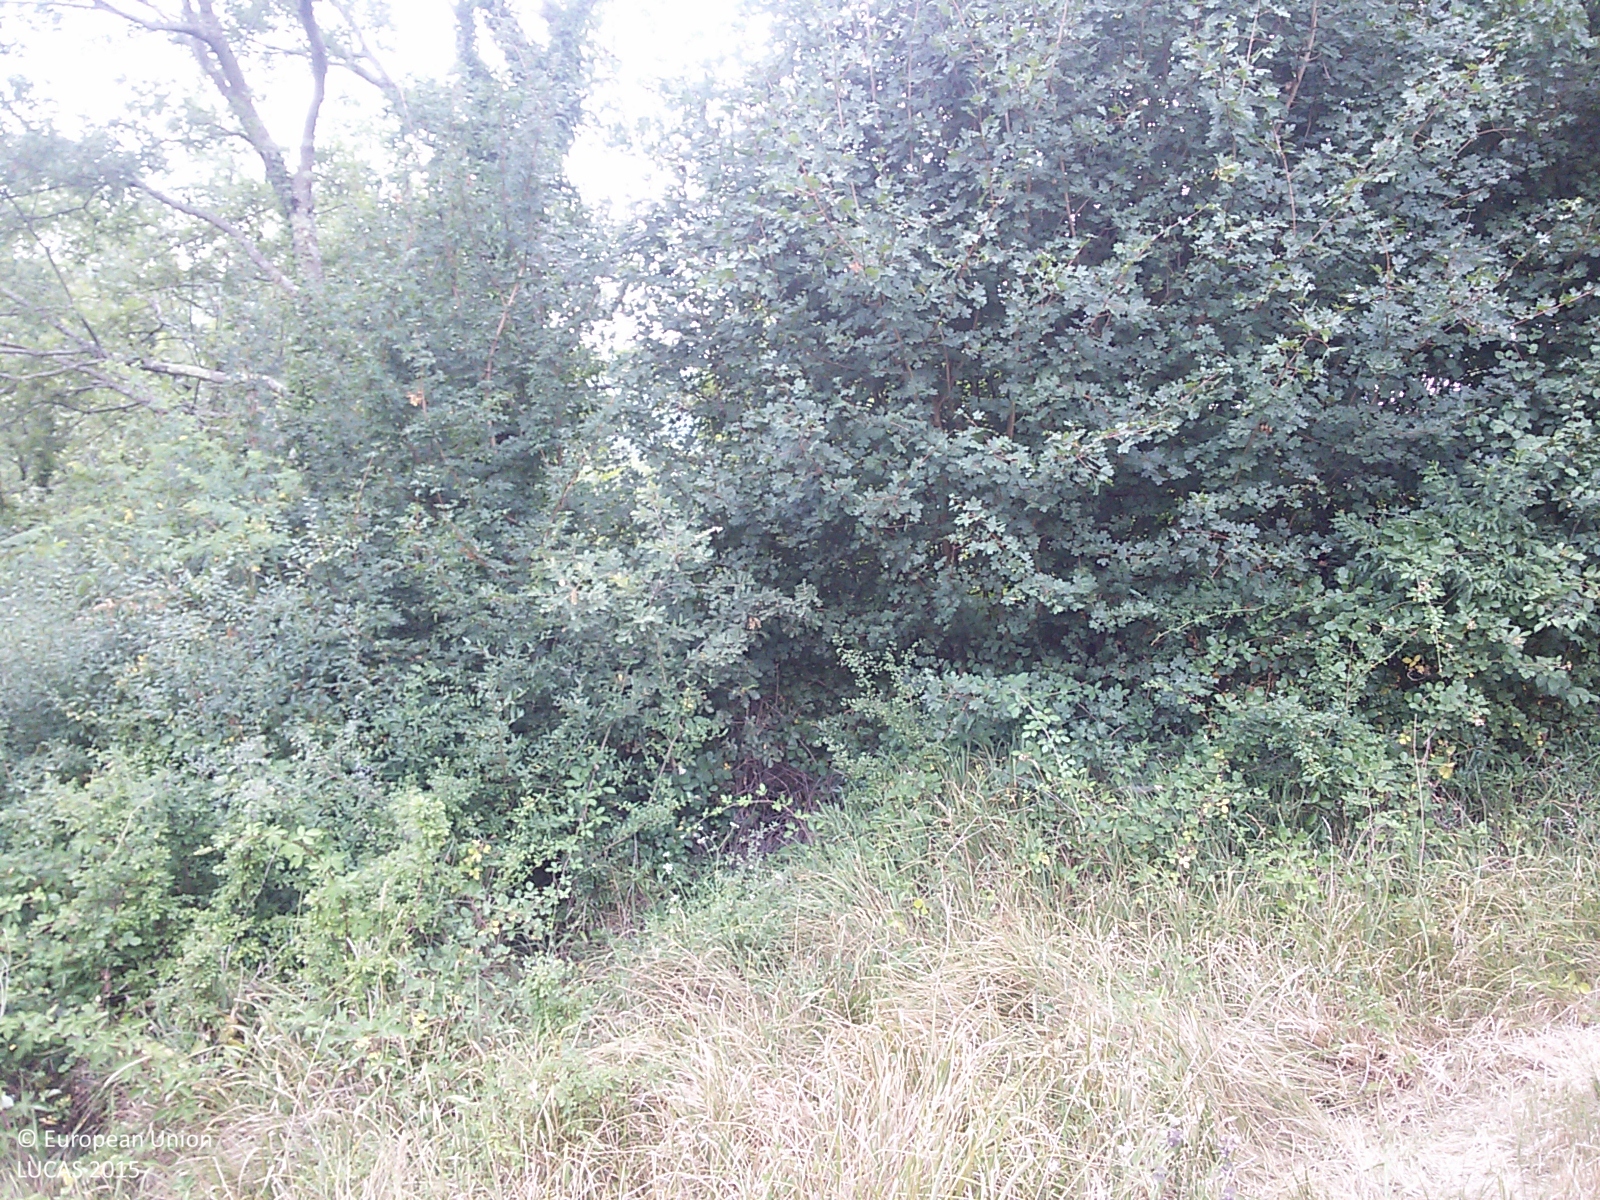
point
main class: Woodland
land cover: Broadleaved woodland
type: thermophilous deciduous forest
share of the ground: > 75 %
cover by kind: broadleaved forest trees 50 %, shrubs 30 %, herbaceous plants 10 %, consolidated bare surface 10 %
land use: Forestry
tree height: < 5 m
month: July
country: IT
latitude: 42.7878
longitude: 11.4744
